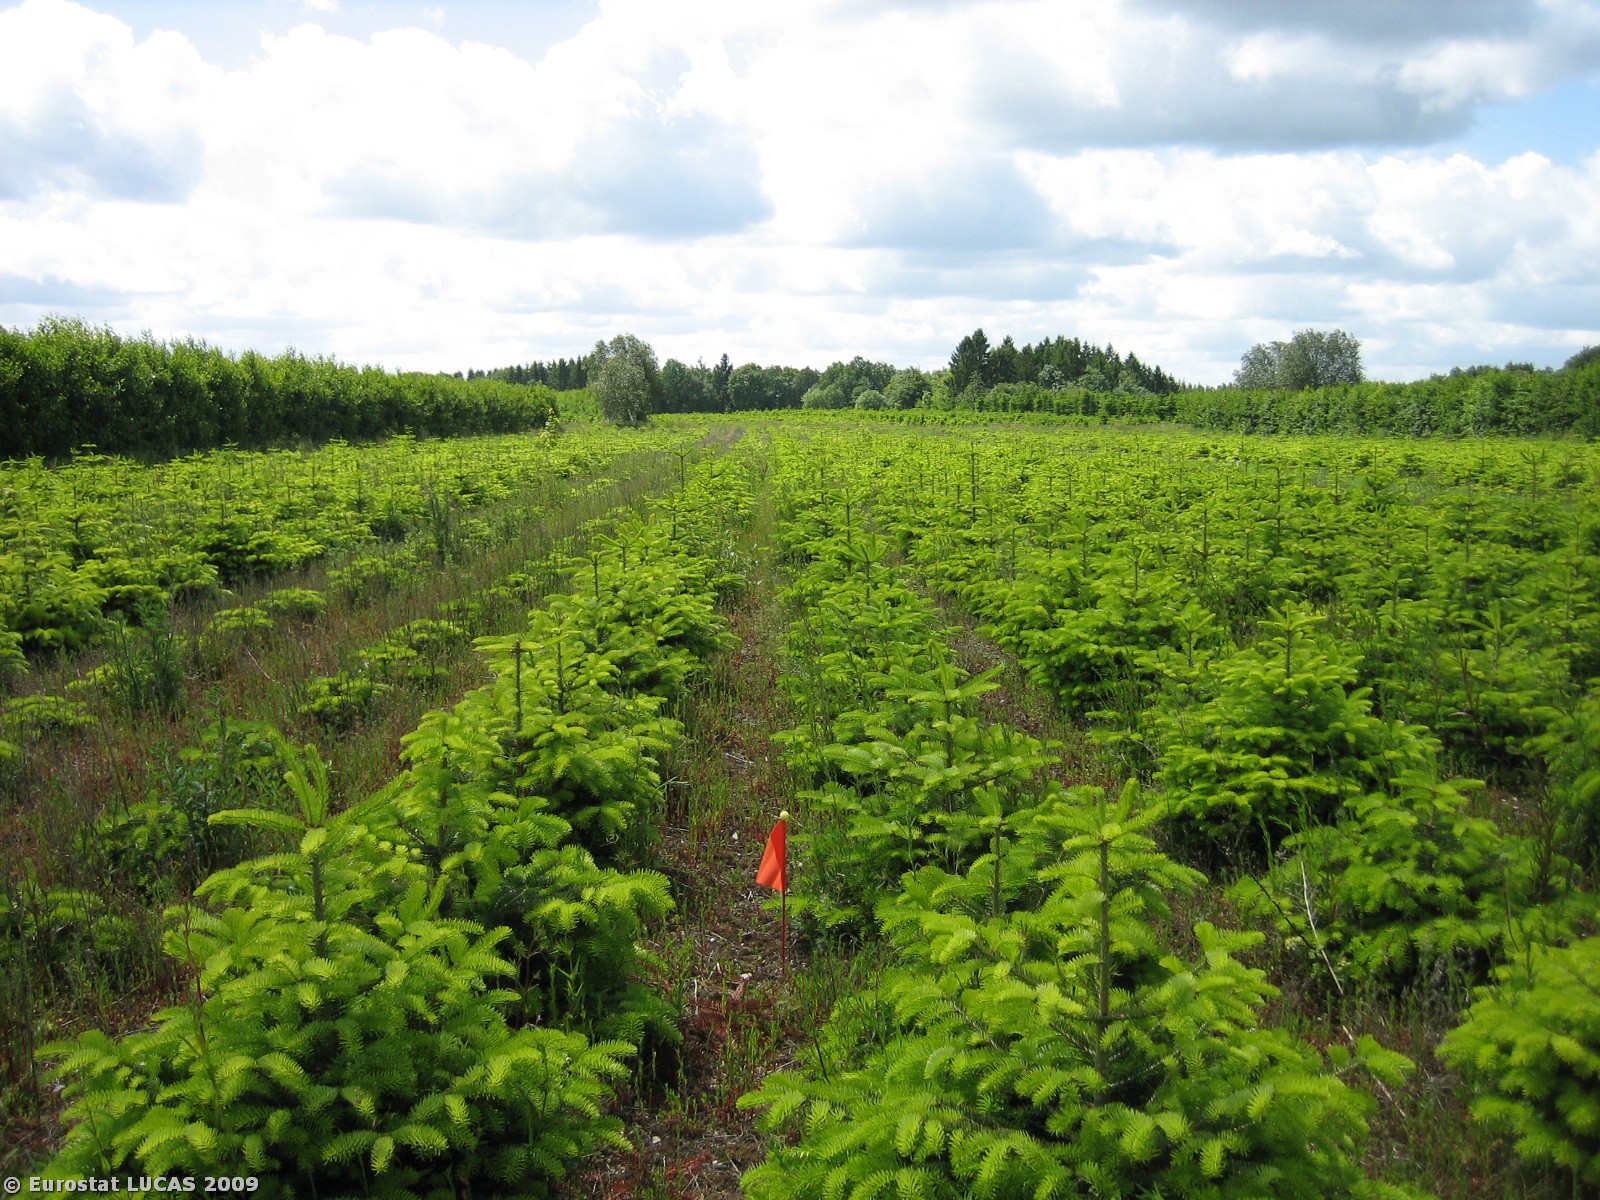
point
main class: Woodland
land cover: Coniferous woodland
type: hemiboreal forest and nemoral coniferous forest and mixed broadleaved-coniferous forest
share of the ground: 50 - 75 %
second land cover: Spontaneously vegetated surfaces
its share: 25 - 50 %
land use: Agriculture (excluding fallow land and kitchen gardens)
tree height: > 5 m
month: June
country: DK
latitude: 55.7184
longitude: 9.2844
